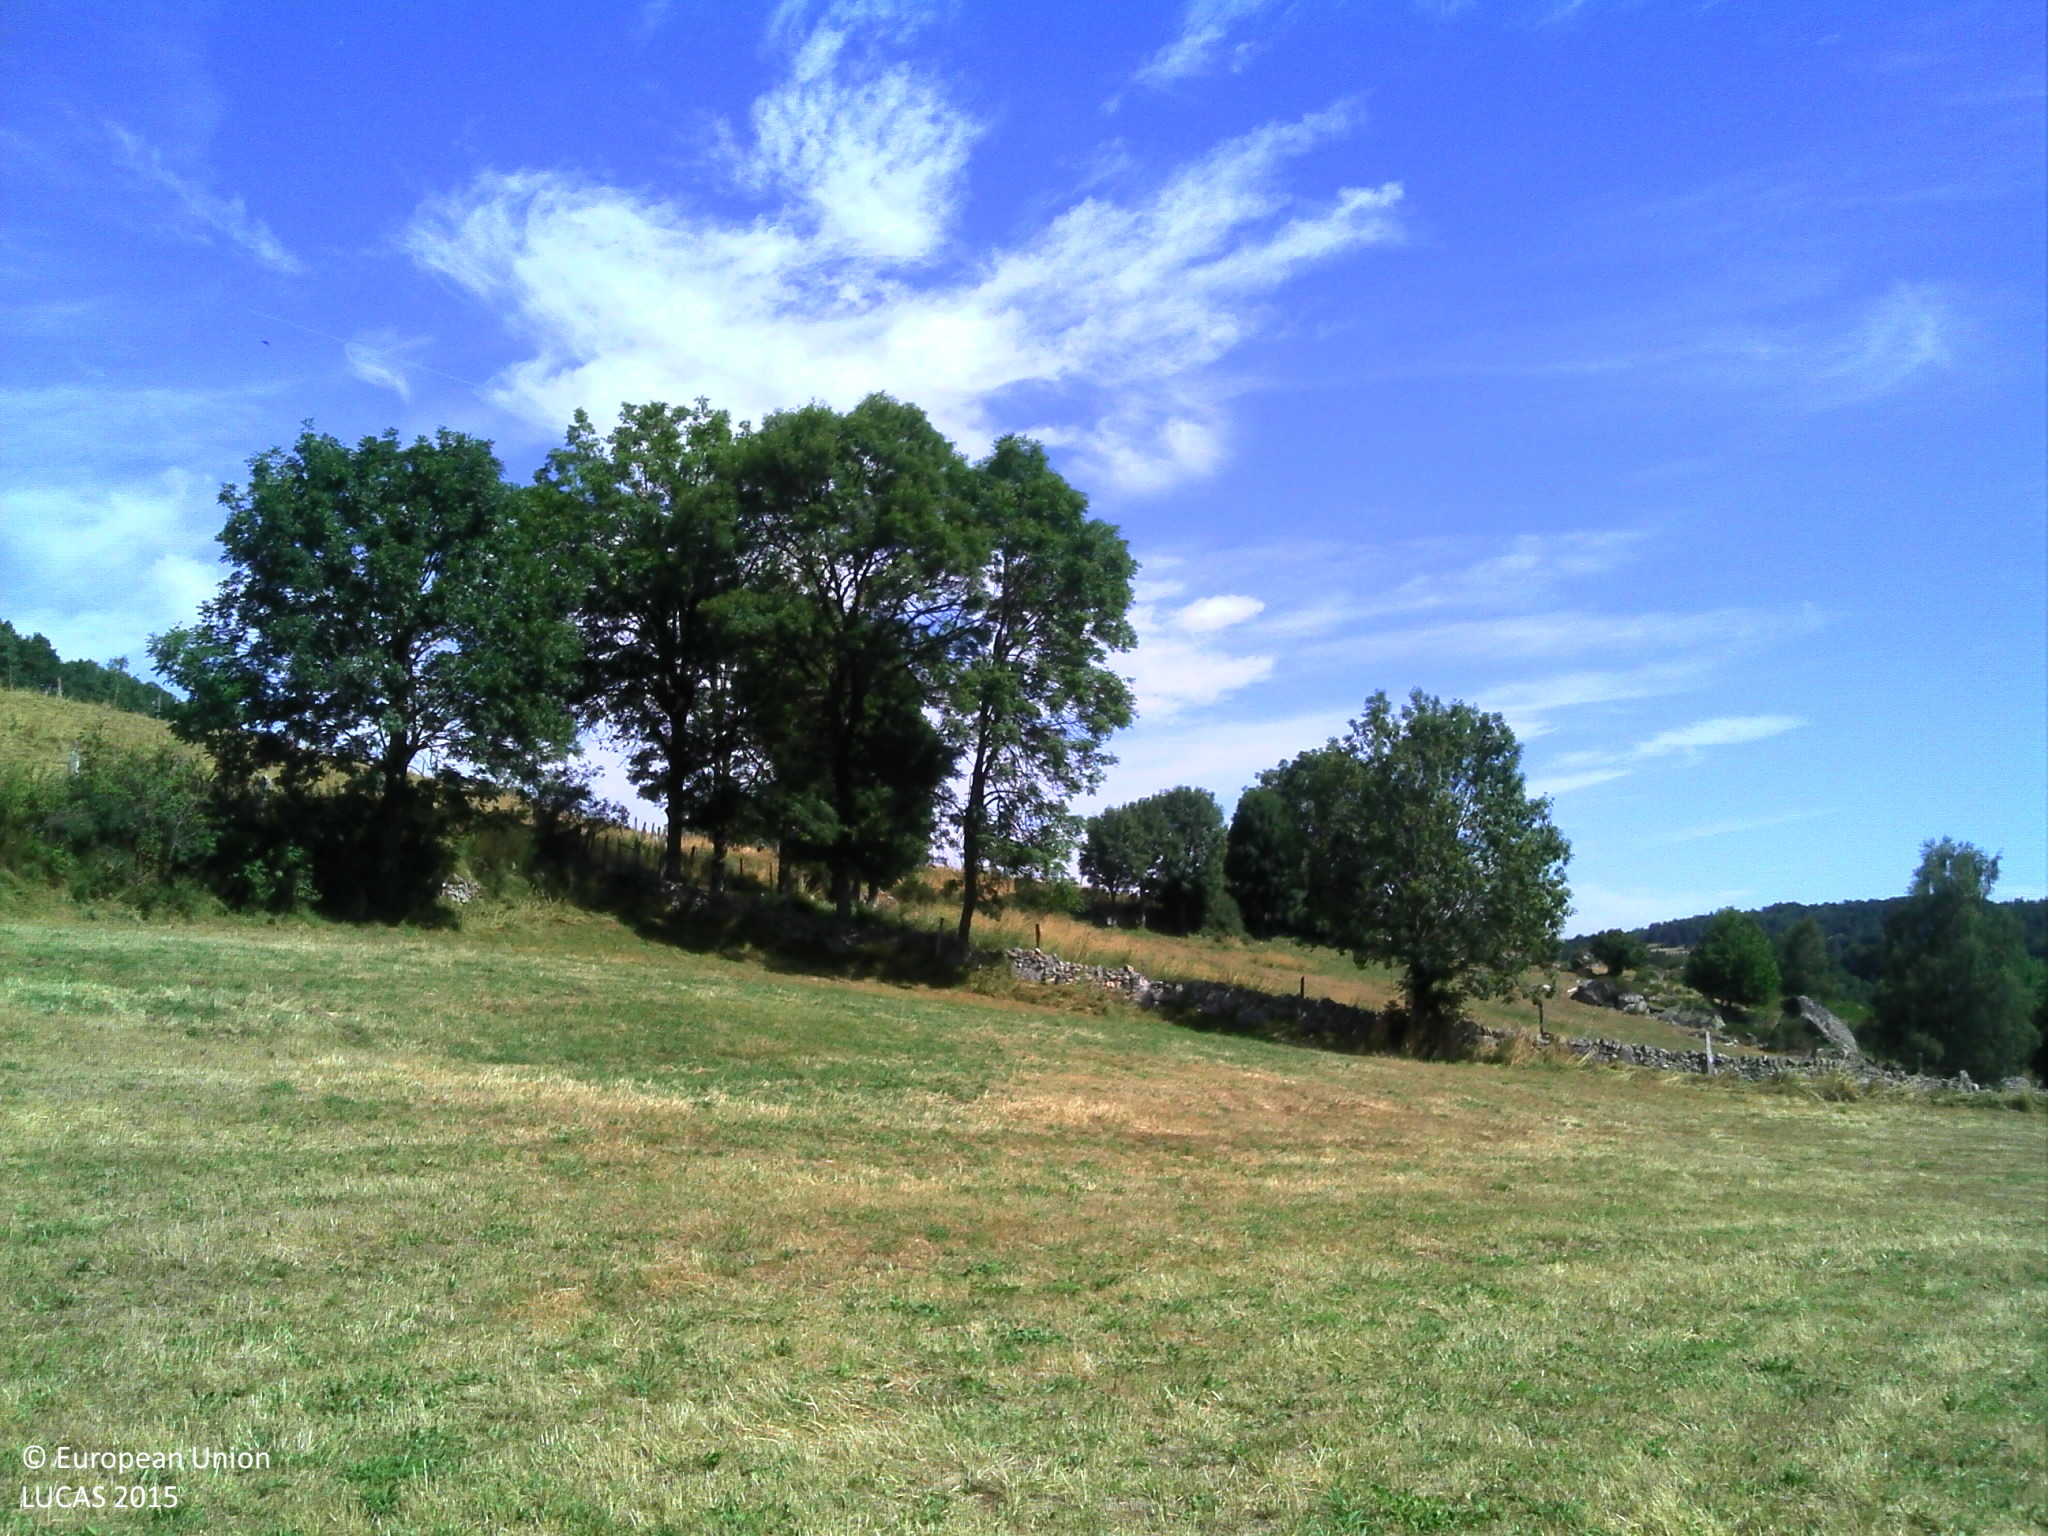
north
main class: Grassland
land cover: Grassland without tree/shrub cover
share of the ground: > 75 %
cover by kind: herbaceous plants 100 %
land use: Agriculture (excluding fallow land and kitchen gardens)
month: July
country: FR
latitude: 44.7260
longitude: 3.2237
